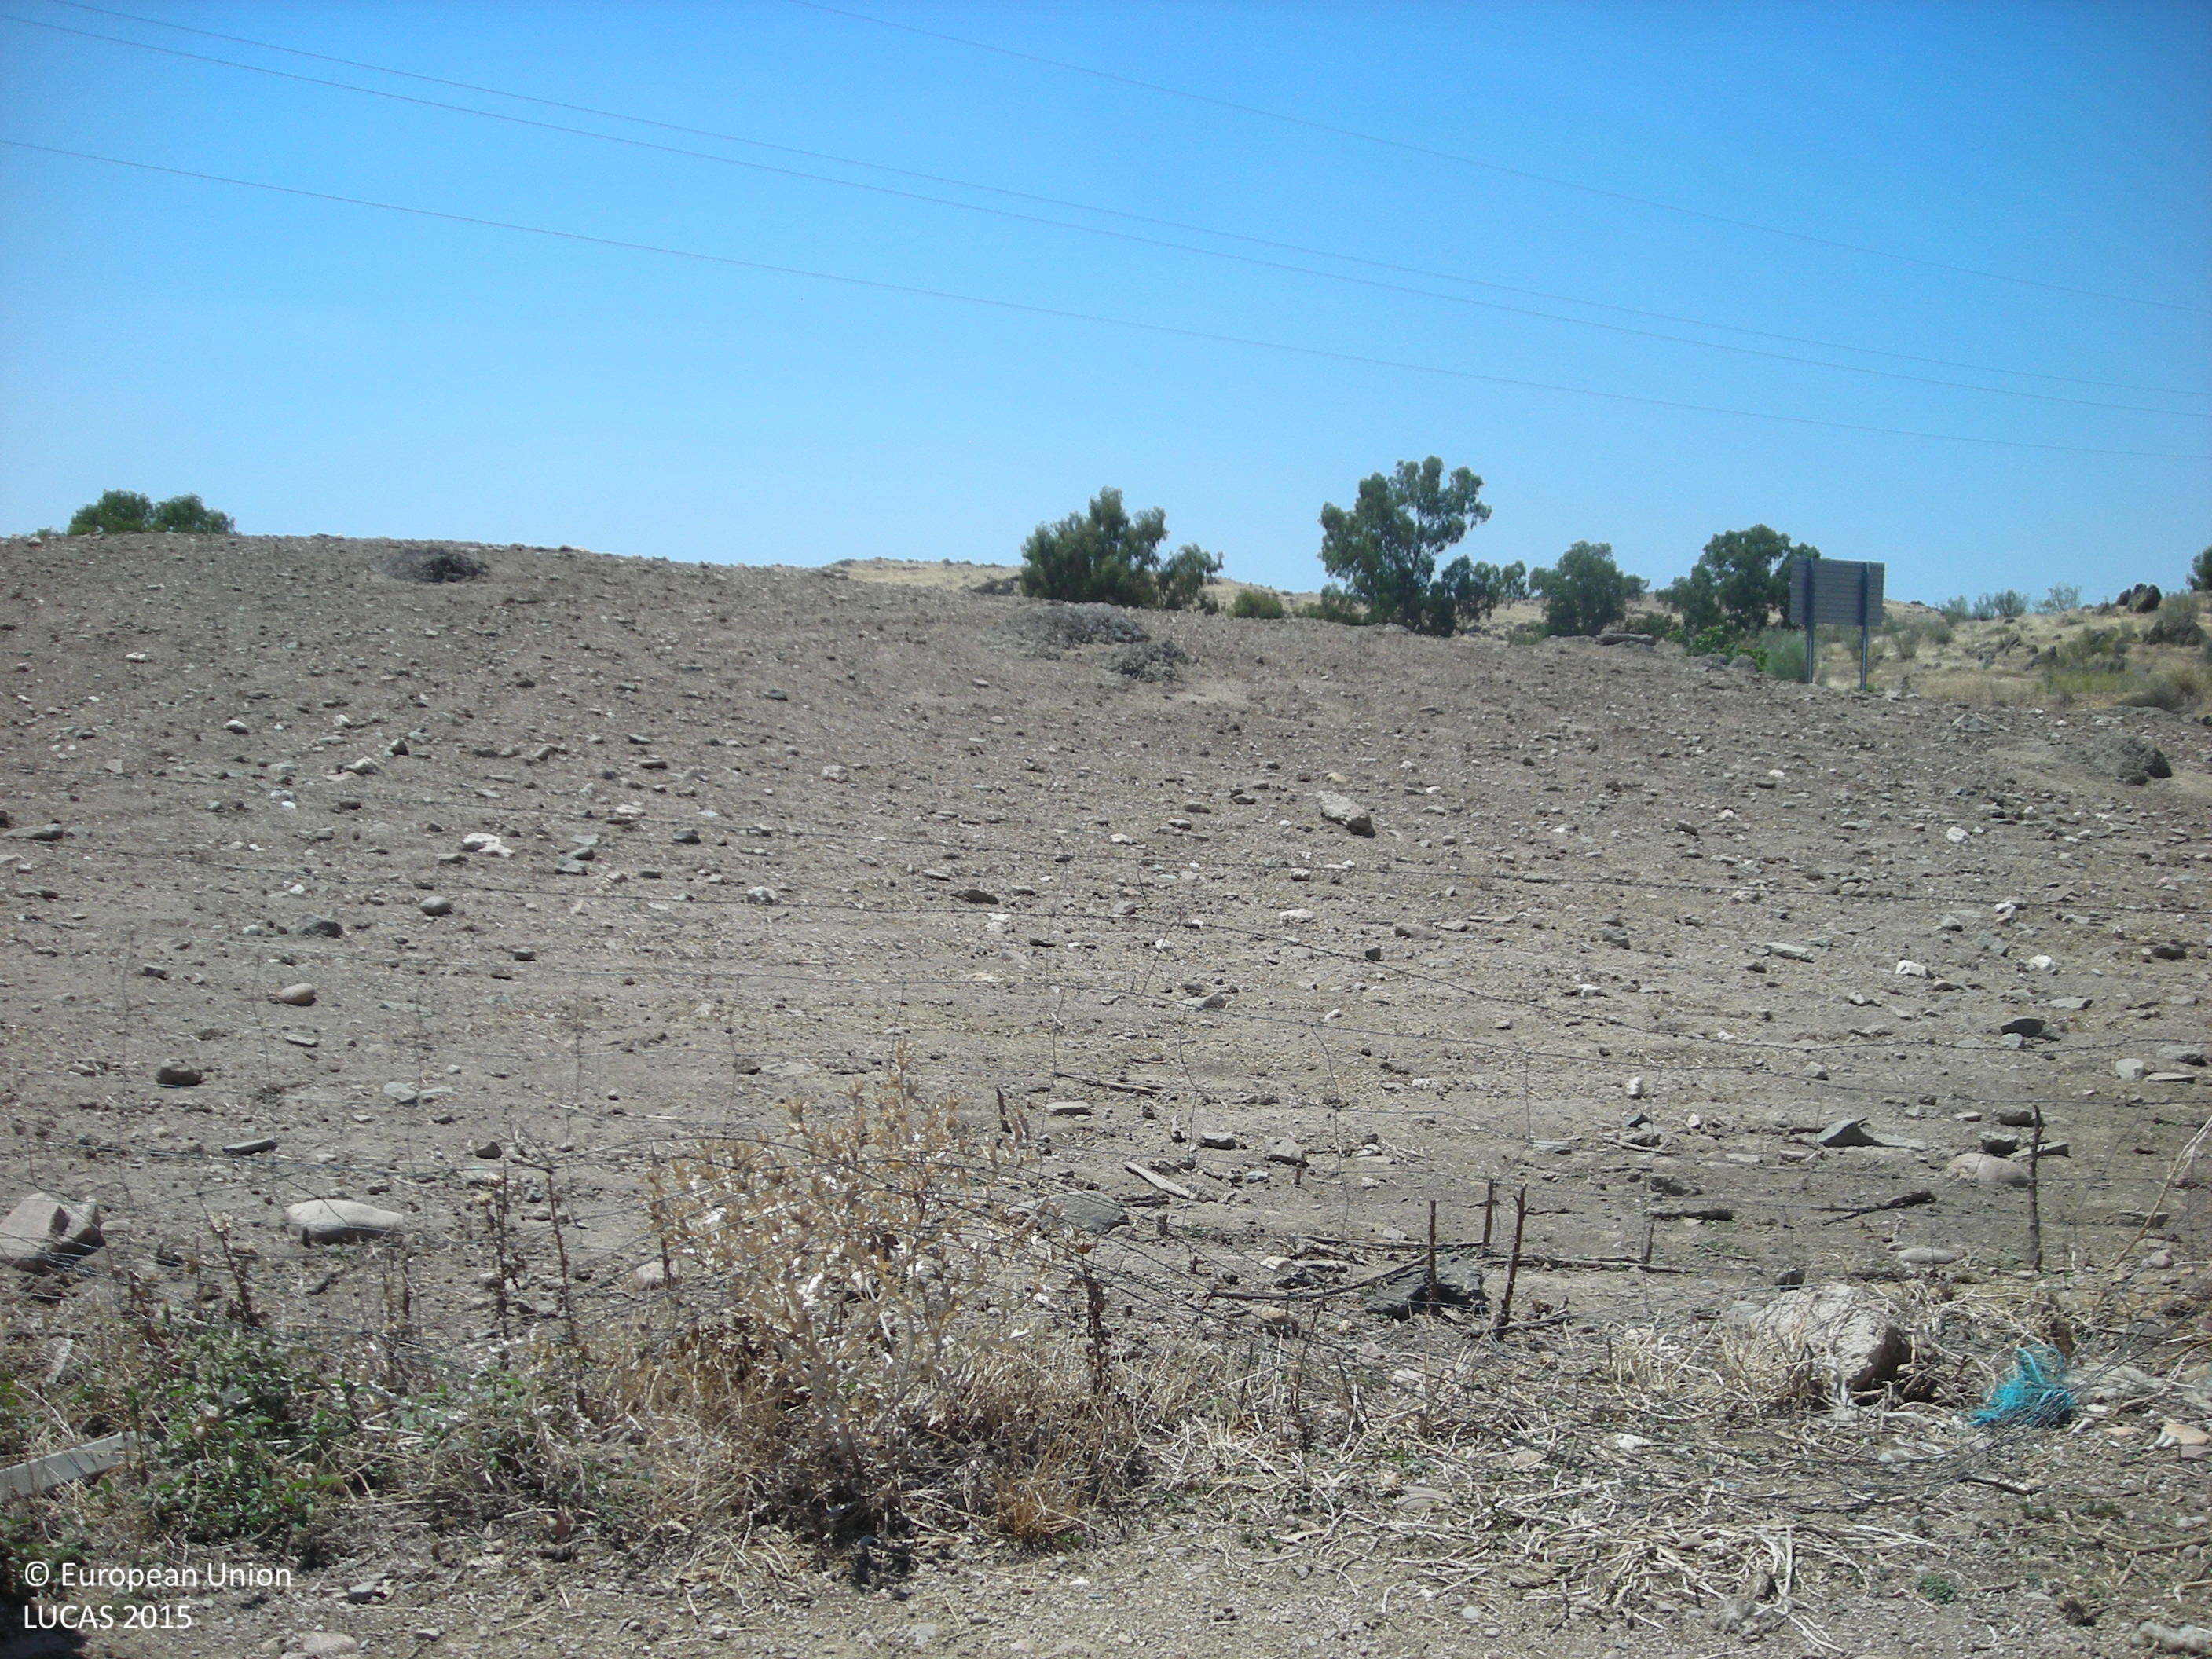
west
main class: Cropland
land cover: Mixed cereals for fodder
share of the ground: > 75 %
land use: Agriculture (excluding fallow land and kitchen gardens)
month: June
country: ES
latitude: 38.9191
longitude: -5.4856
